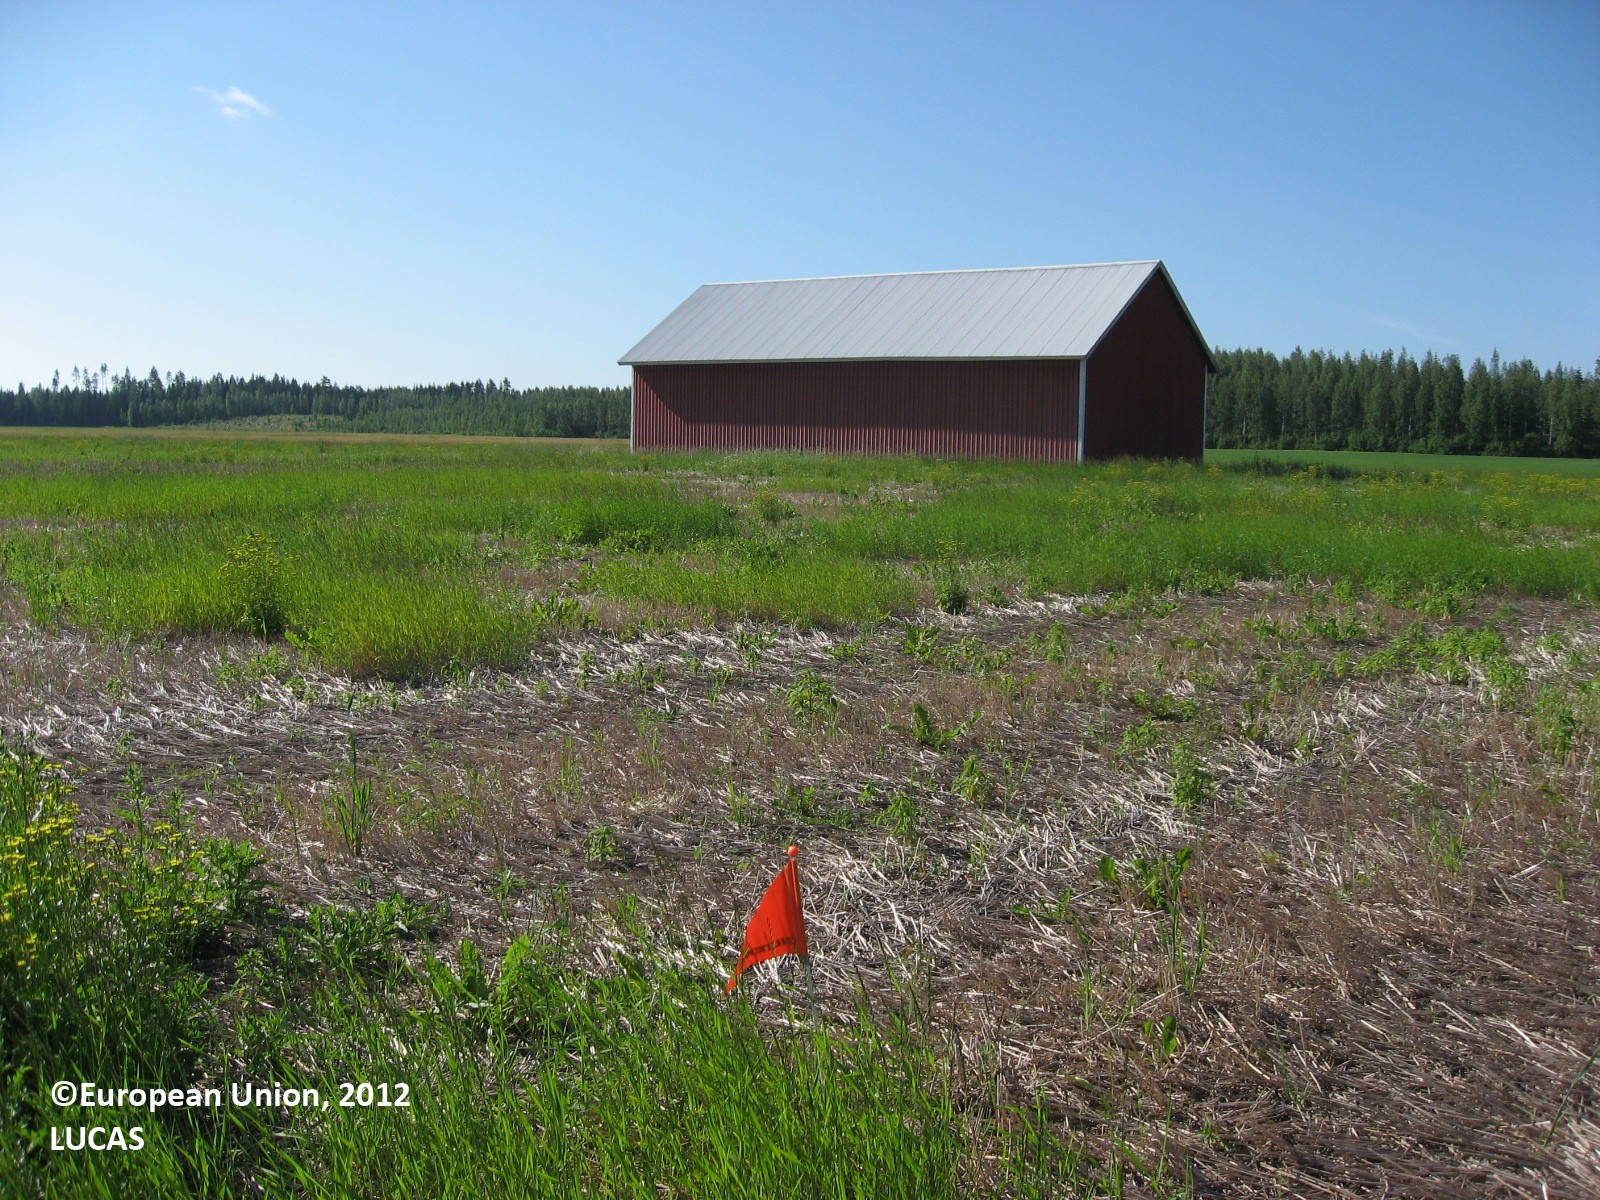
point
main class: Grassland
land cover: Spontaneously vegetated surfaces
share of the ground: 50 - 75 %
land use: Fallow land
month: July
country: FI
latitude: 60.8478
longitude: 26.2865
